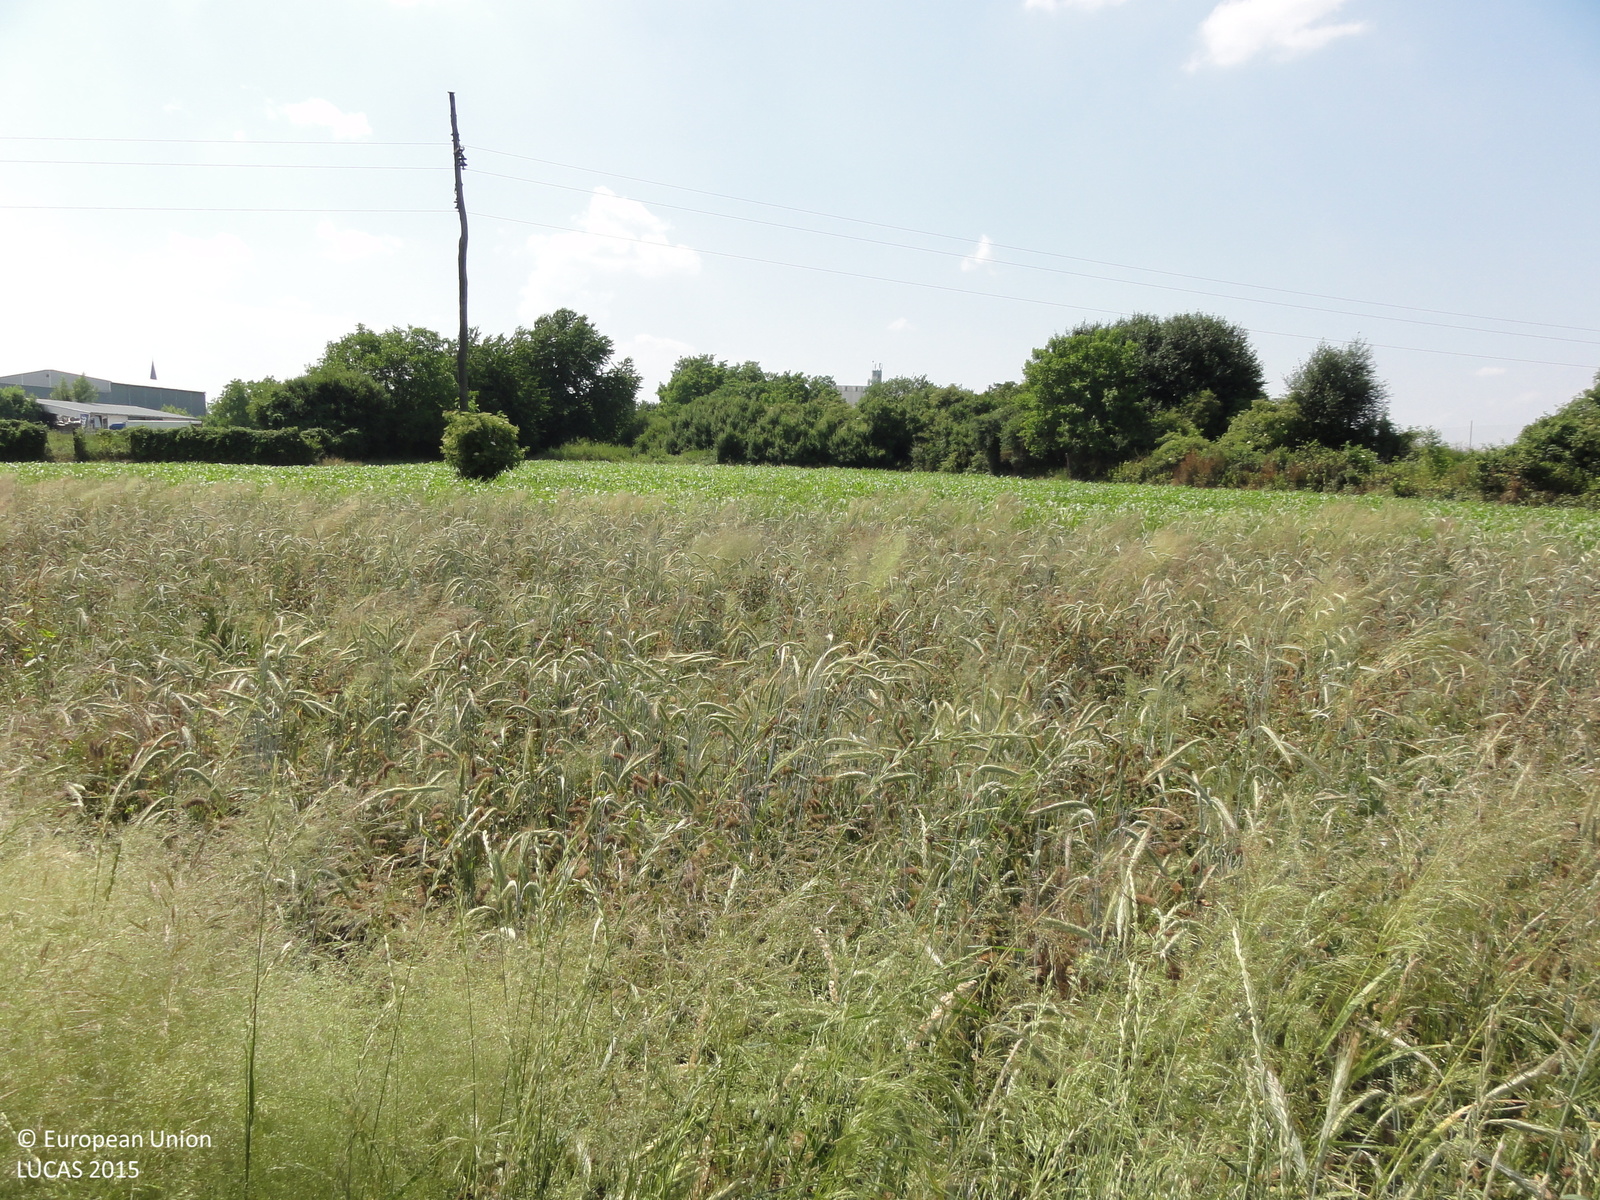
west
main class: Cropland
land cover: Barley
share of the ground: > 75 %
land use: Agriculture (excluding fallow land and kitchen gardens)
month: June
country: SI
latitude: 46.6600
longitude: 16.1821
